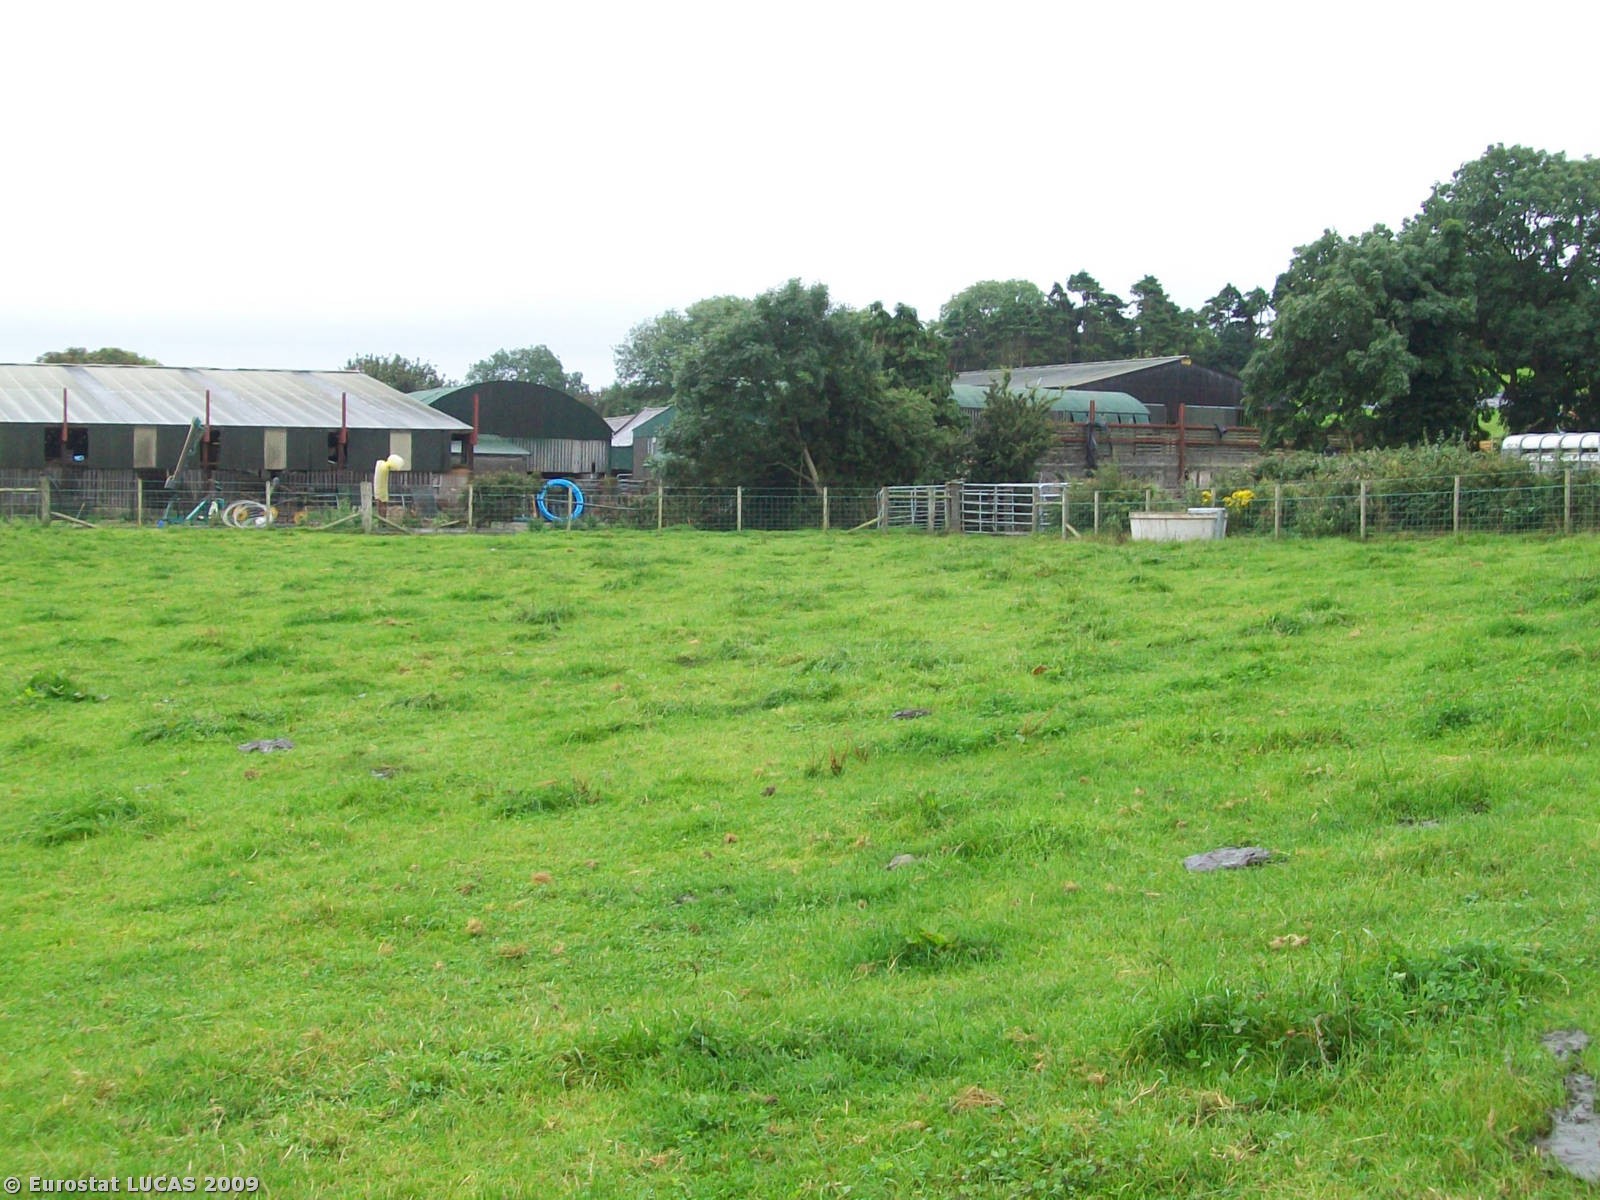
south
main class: Grassland
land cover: Grassland without tree/shrub cover
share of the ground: > 75 %
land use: Agriculture (excluding fallow land and kitchen gardens)
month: August
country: GB
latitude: 54.3492
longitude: -5.5602
